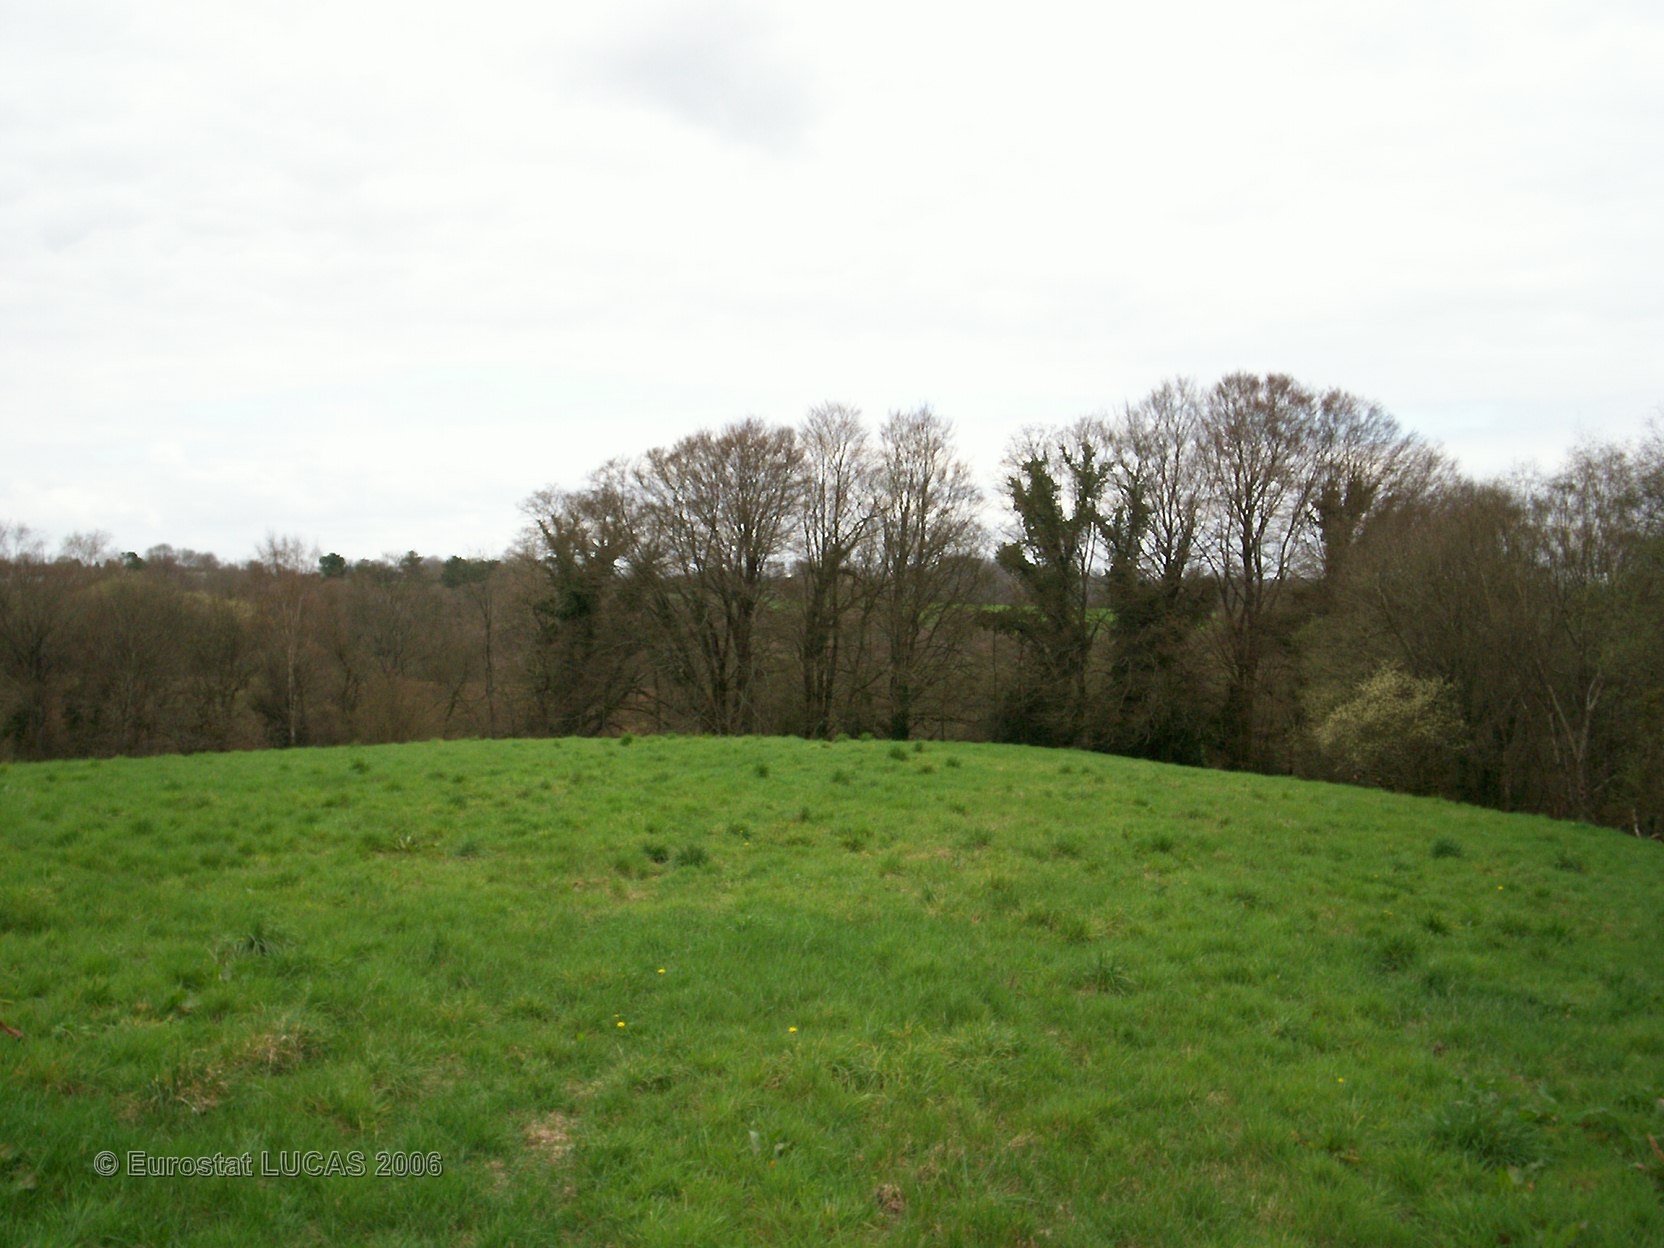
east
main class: Grassland
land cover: Grassland without tree/shrub cover
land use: Agriculture (excluding fallow land and kitchen gardens)
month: April
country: FR
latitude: 47.9883
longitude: -3.5166
